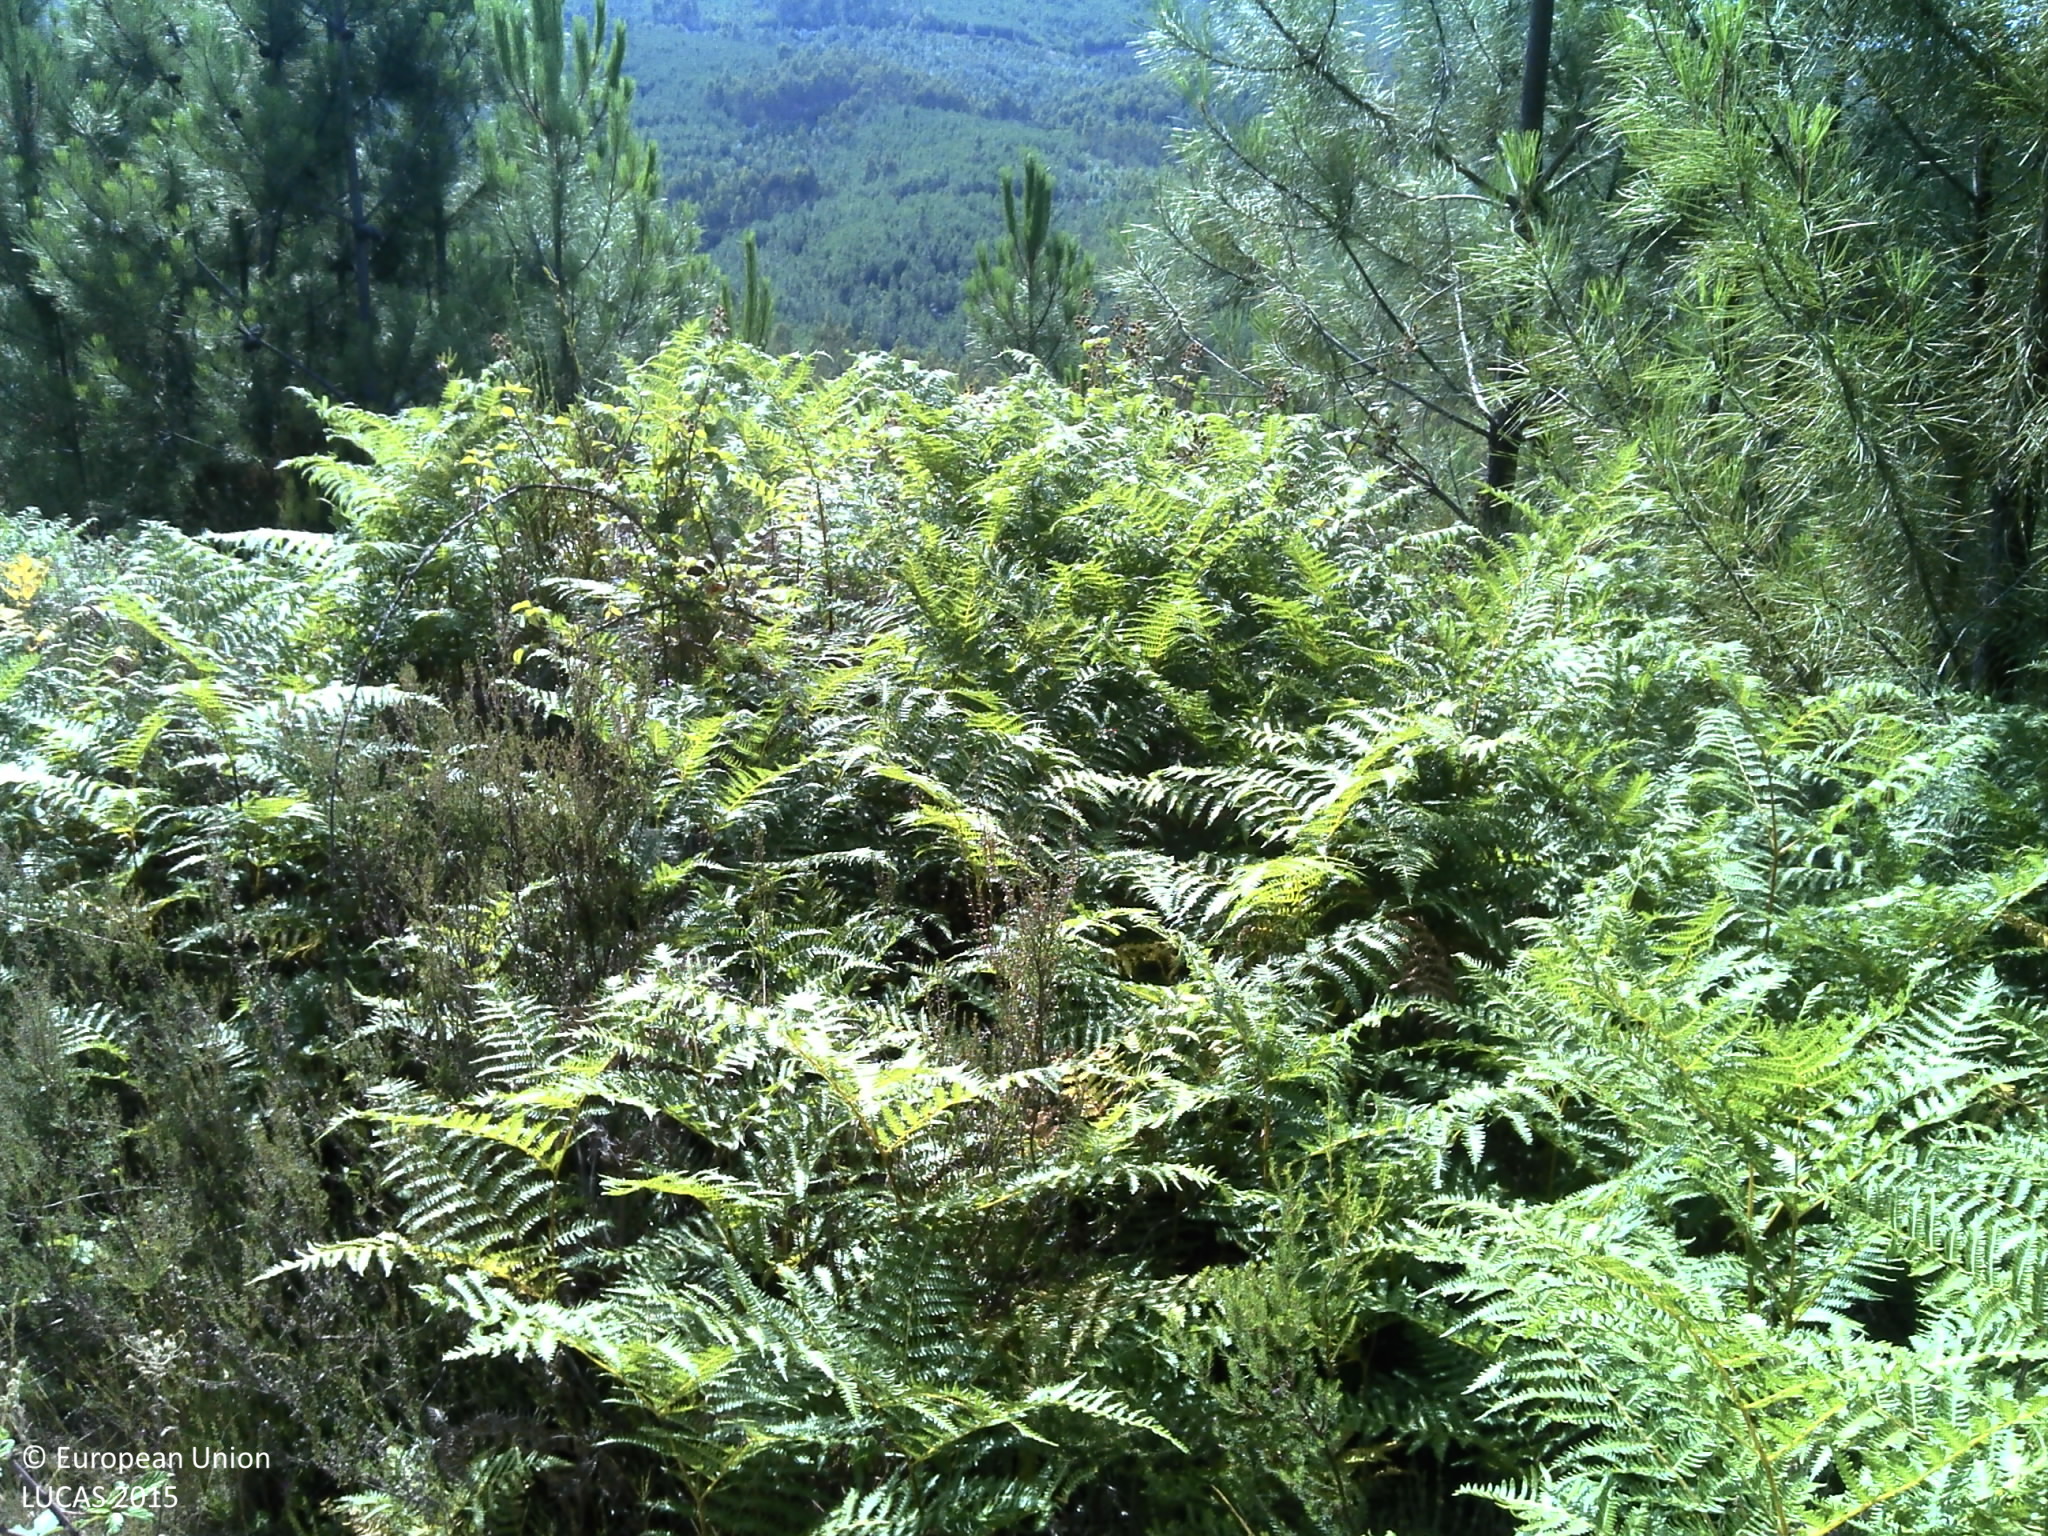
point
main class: Woodland
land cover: Pine dominated coniferous woodland
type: coniferous forest of the mediterranean region
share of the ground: 25 - 50 %
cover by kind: shrubs 65 %, coniferous forest trees 30 %, herbaceous plants 5 %
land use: Forestry
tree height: > 5 m
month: July
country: PT
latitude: 39.9130
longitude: -8.0244
